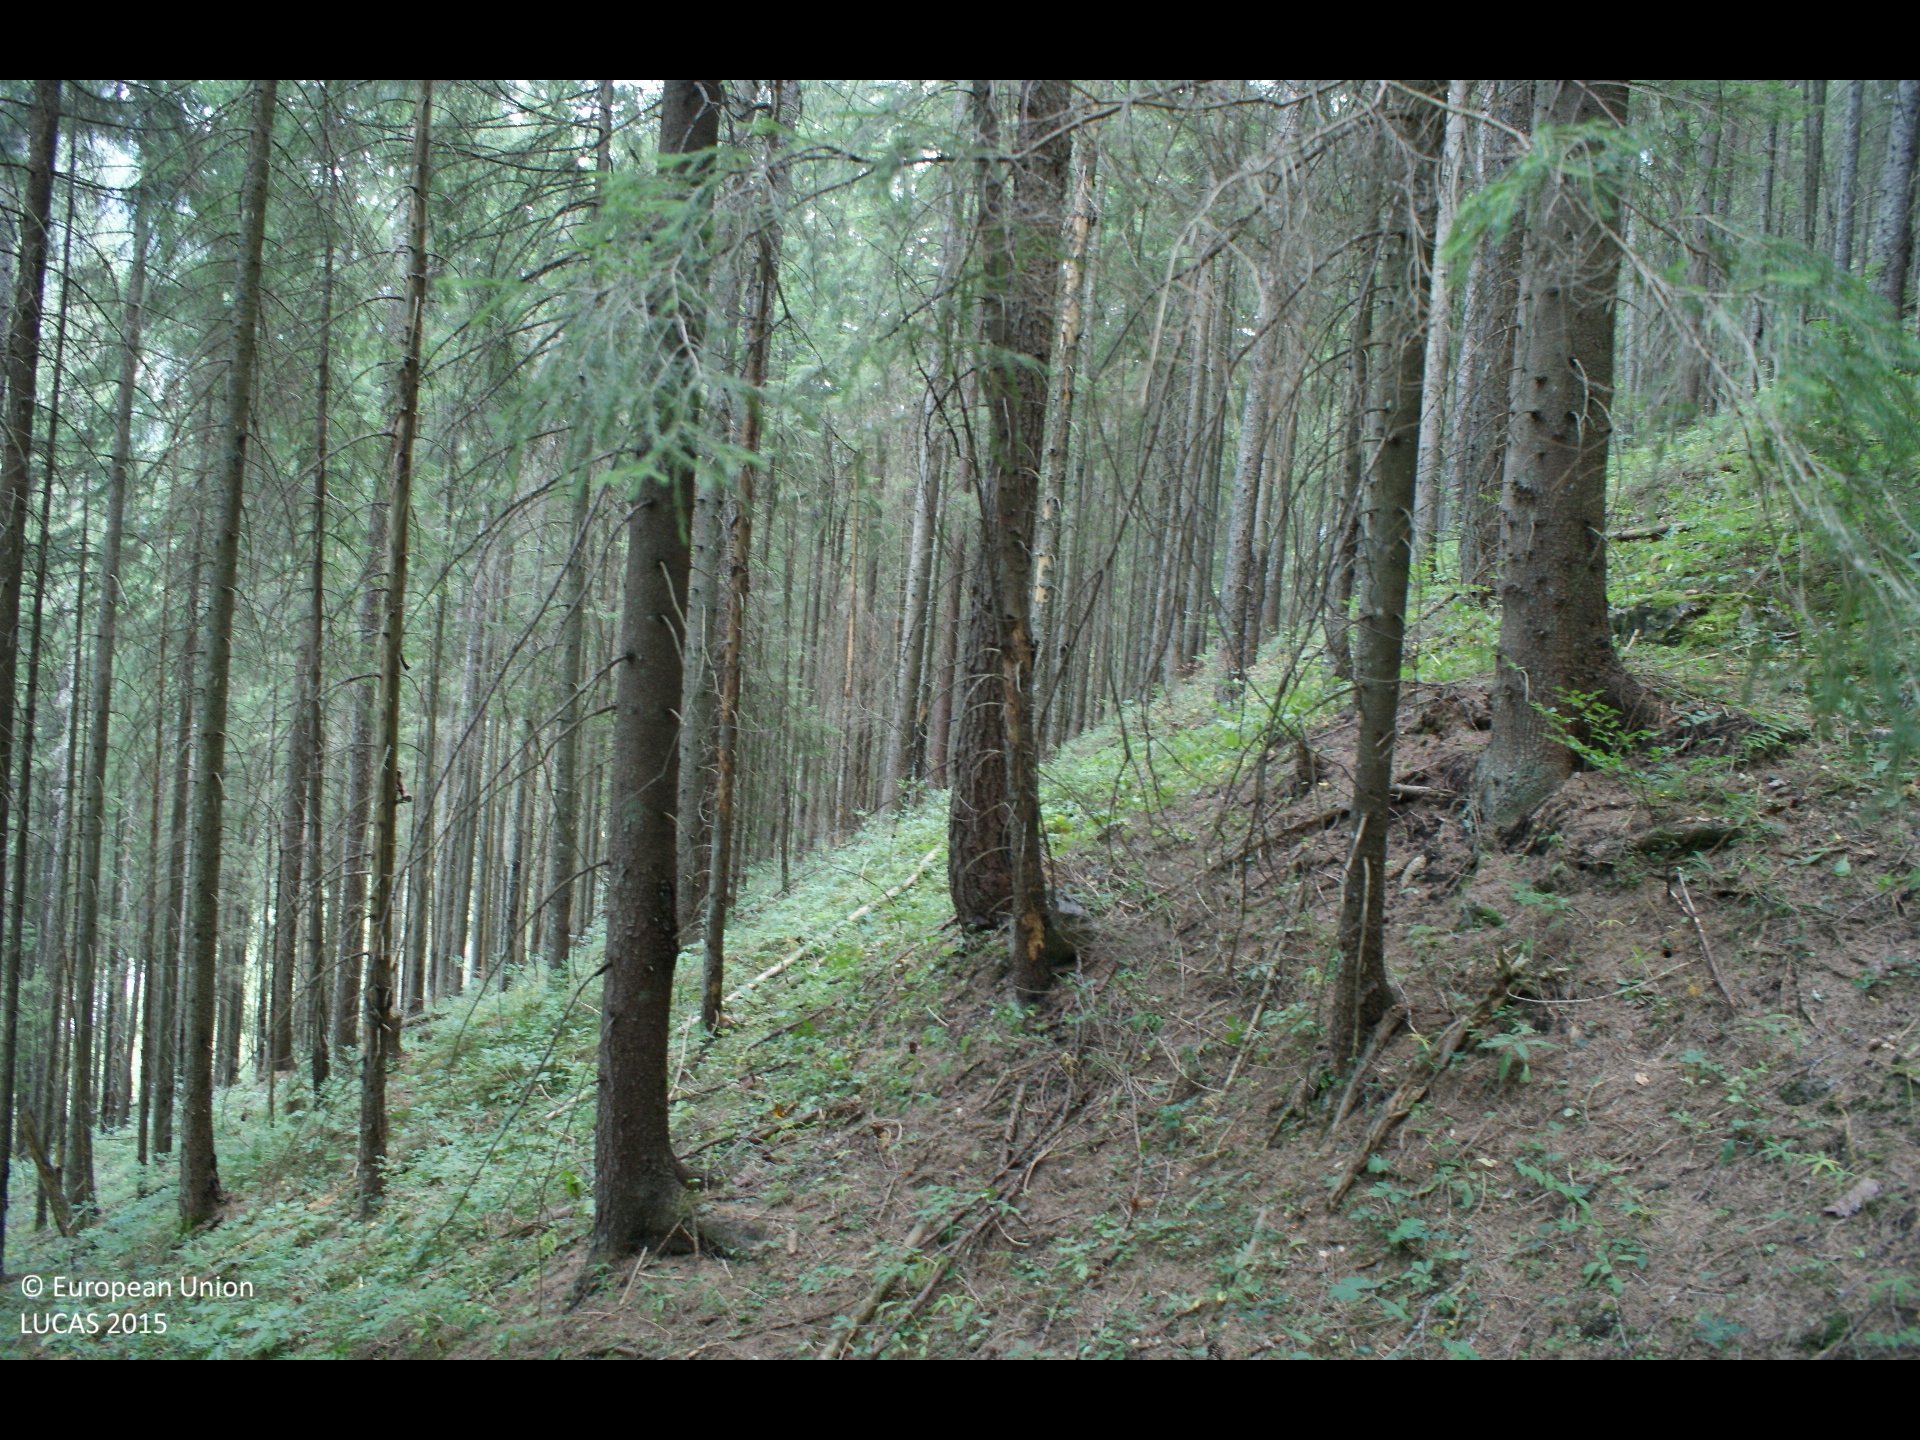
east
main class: Woodland
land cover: Spruce dominated coniferous woodland
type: alpine coniferous forest
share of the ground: > 75 %
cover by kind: coniferous forest trees 80 %, herbaceous plants 10 %, lichens and mosses 10 %
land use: Forestry
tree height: > 5 m
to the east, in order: Spruce dominated coniferous woodland; Shrubland without tree cover; Shrubland with sparse tree cover; Shrubland without tree cover
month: August
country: AT
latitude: 47.7344
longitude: 15.3215
